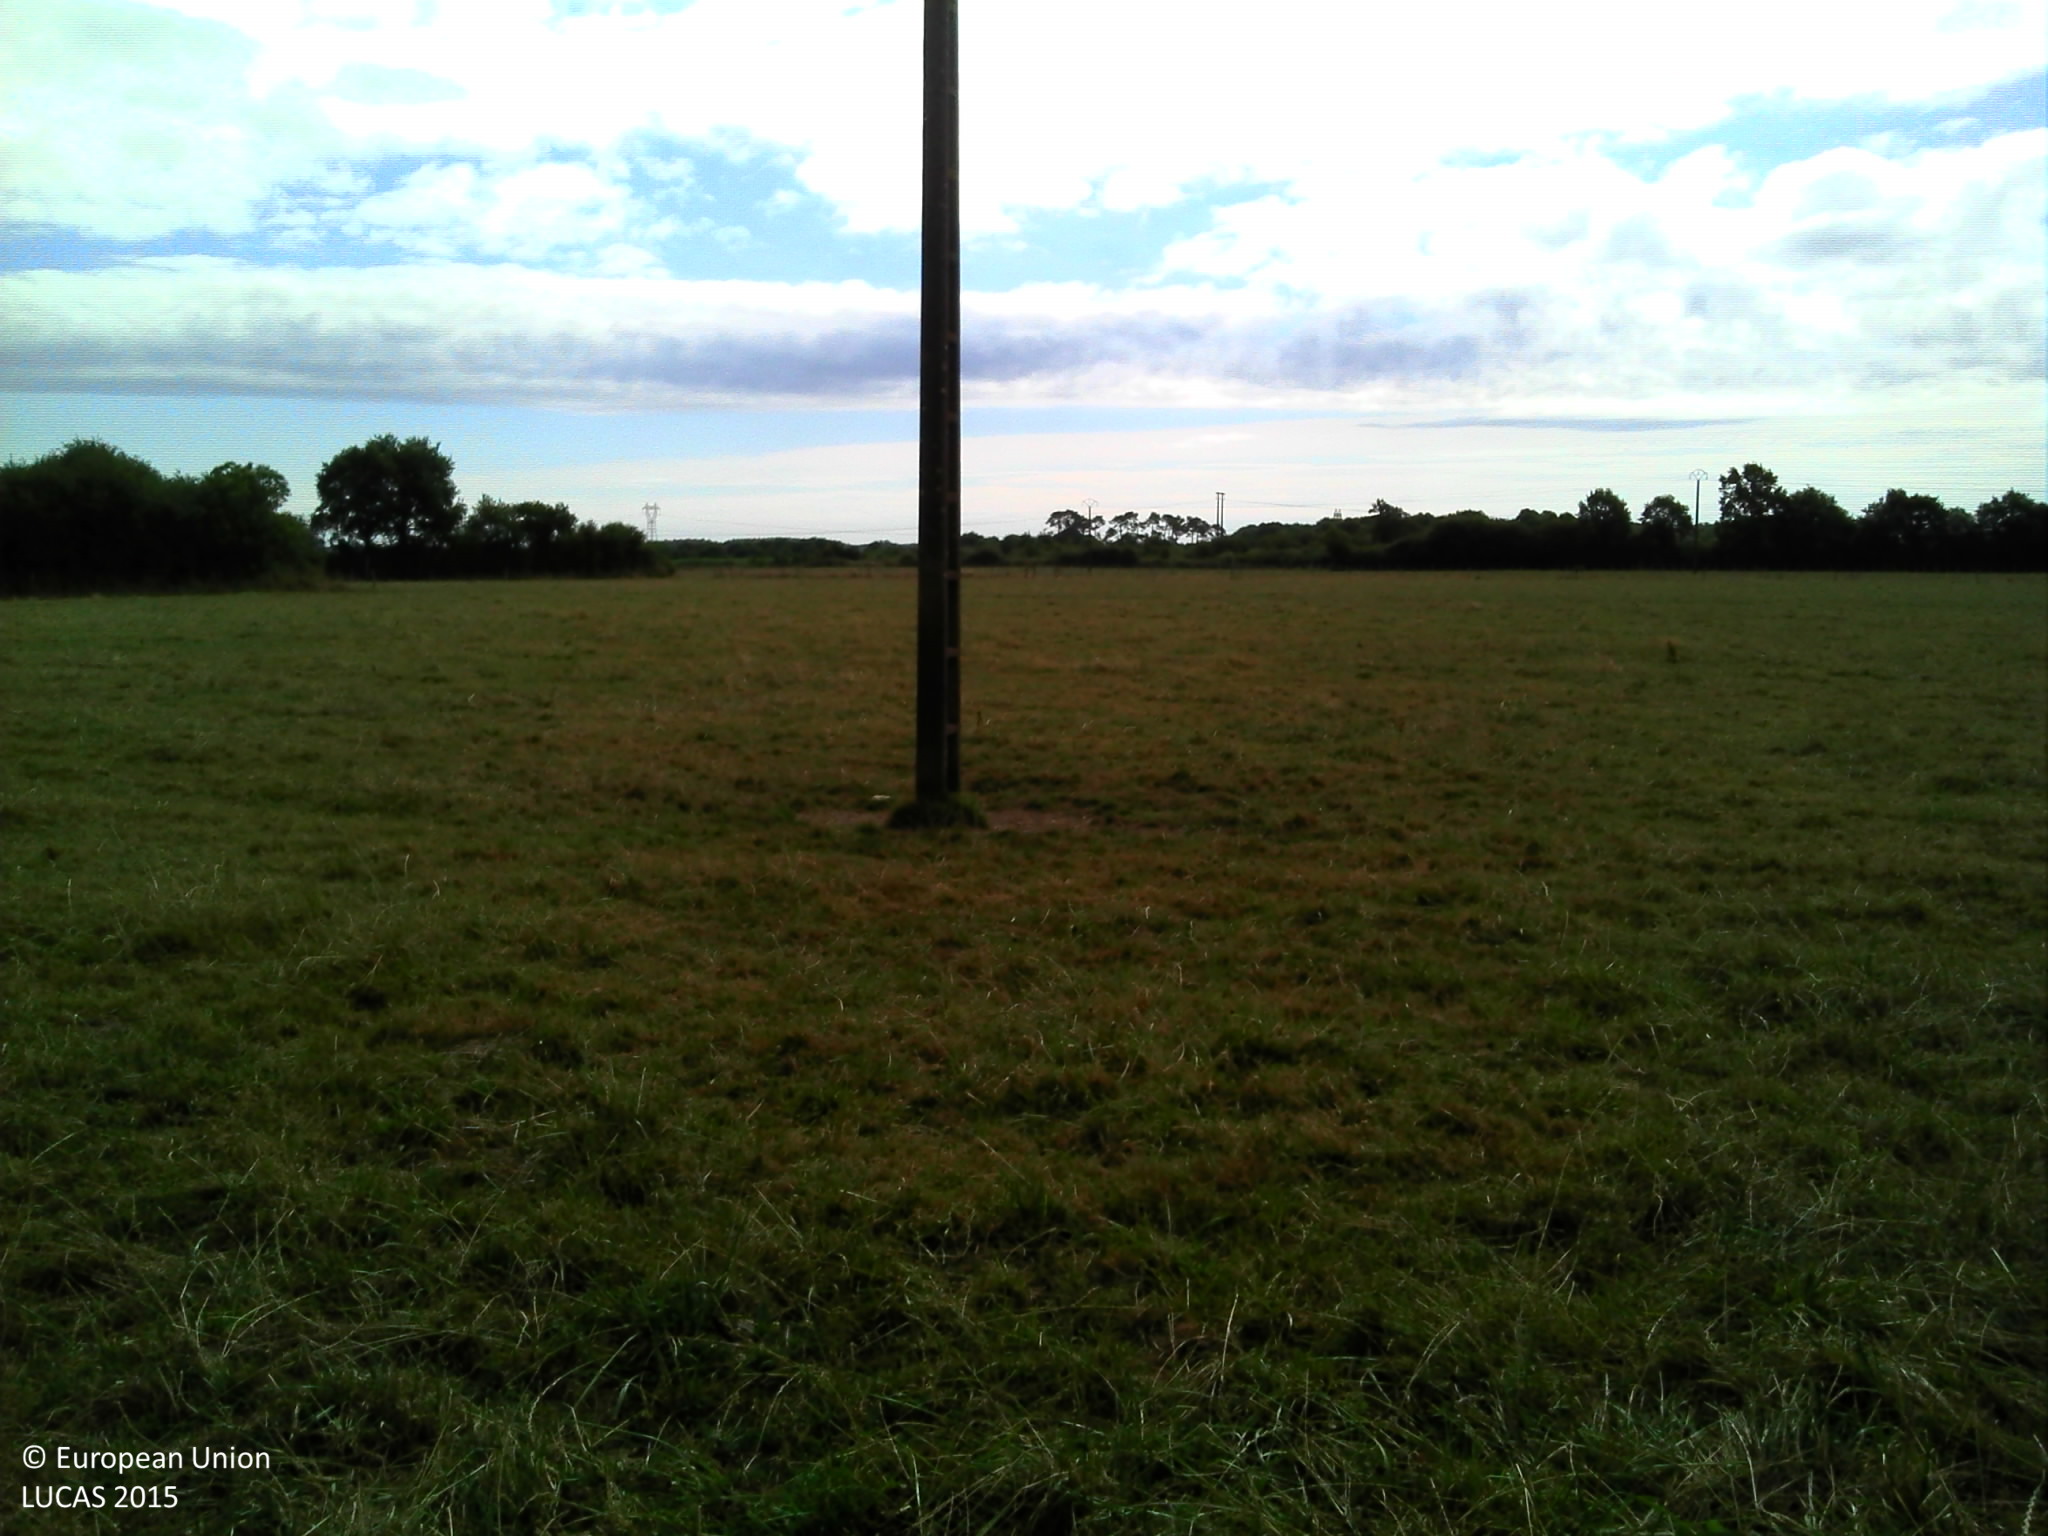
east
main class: Cropland
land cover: Temporary grasslands
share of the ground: > 75 %
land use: Agriculture (excluding fallow land and kitchen gardens)
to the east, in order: Temporary grasslands; Electric lines; Temporary grasslands; Fences; Ditches and canals; Fences; Temporary grasslands
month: July
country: FR
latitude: 47.4828
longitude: -2.0875
